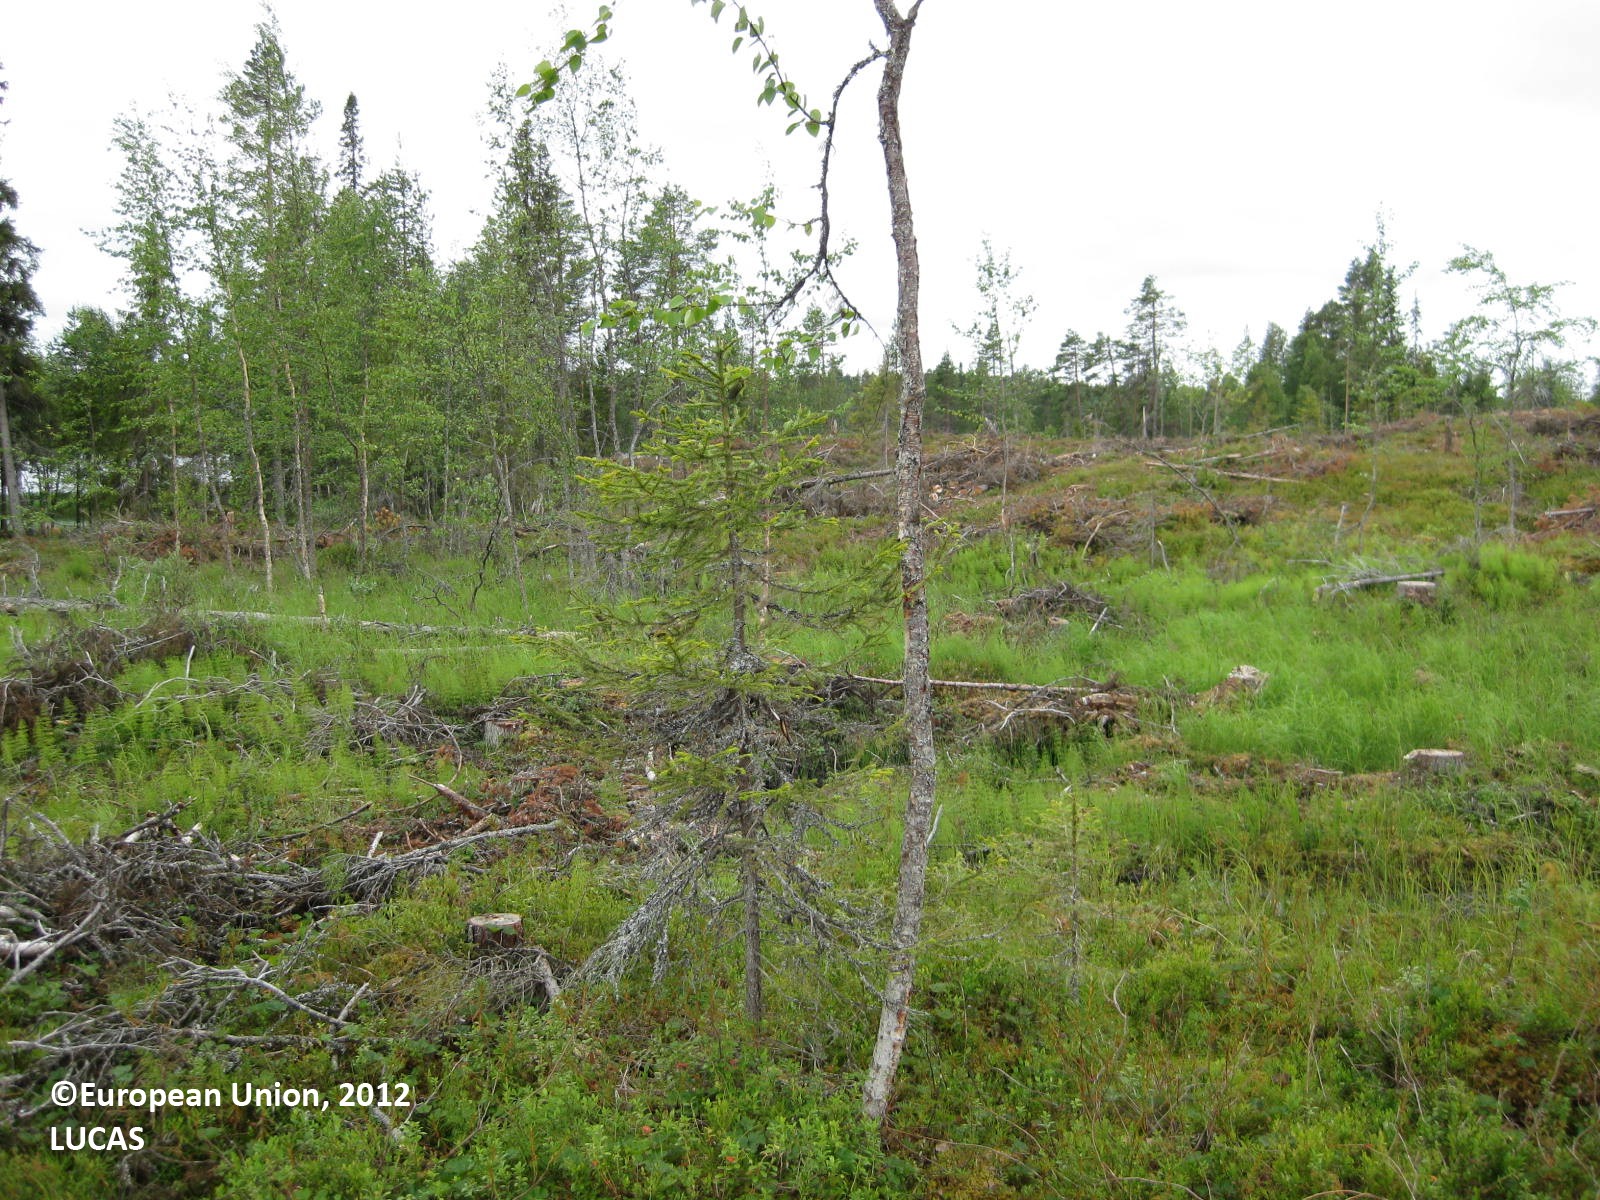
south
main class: Woodland
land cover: Broadleaved woodland
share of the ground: 10 - 25 %
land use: Forestry
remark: Clear cut
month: July
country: FI
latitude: 65.8618
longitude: 29.7277
